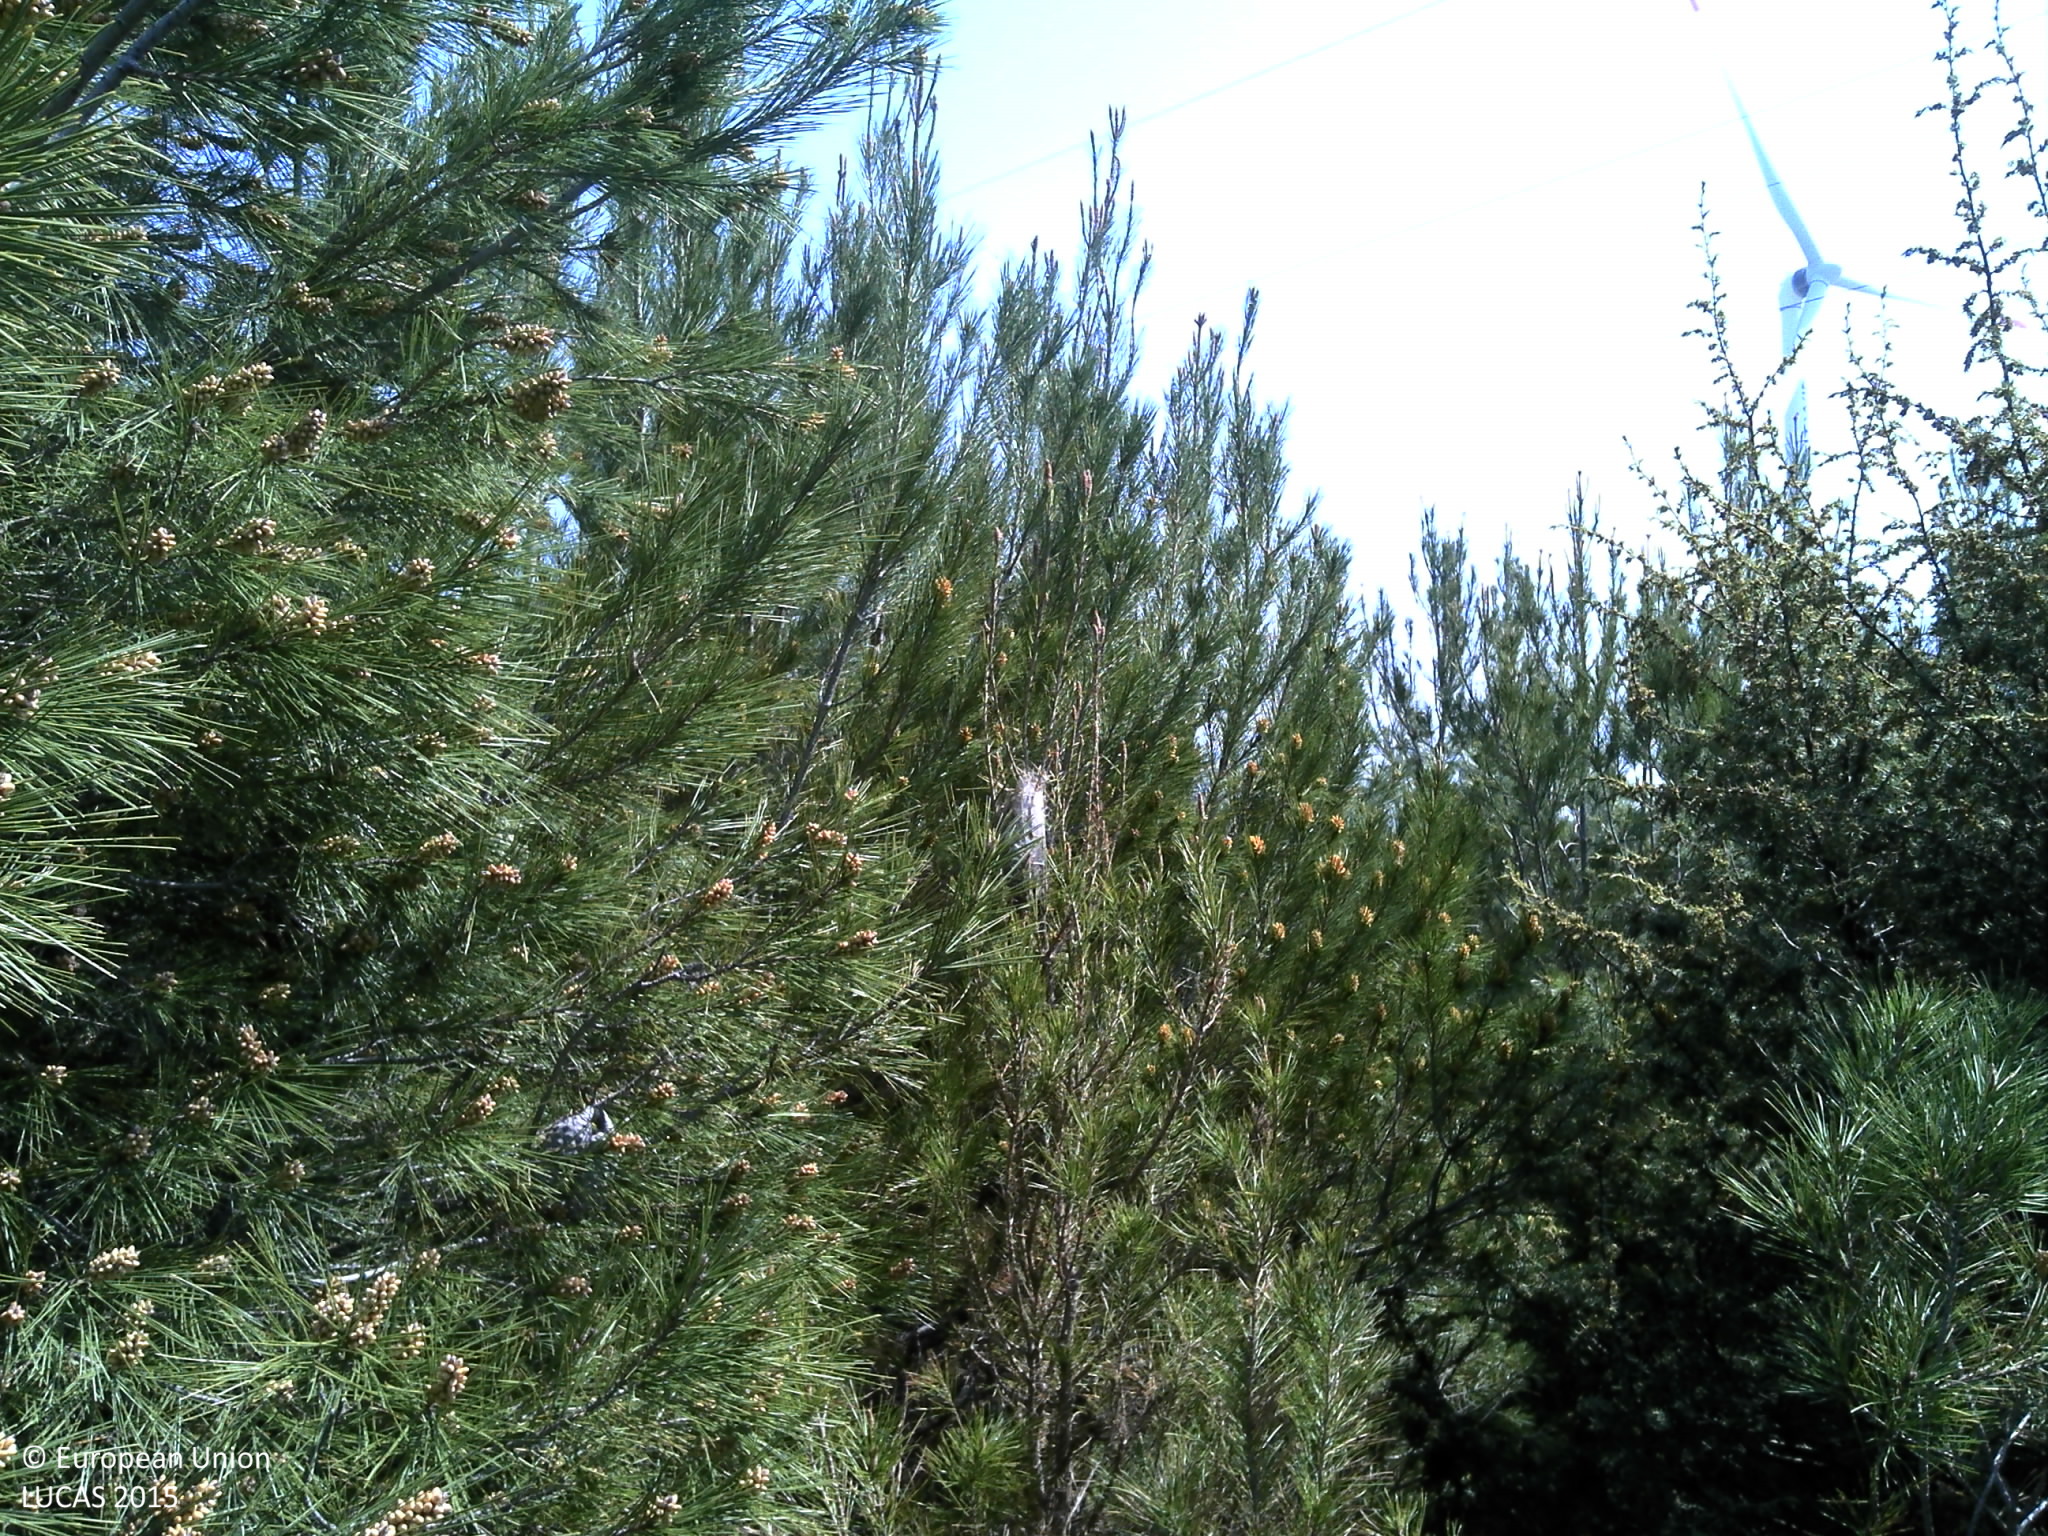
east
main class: Woodland
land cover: Pine dominated coniferous woodland
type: coniferous forest of the mediterranean region
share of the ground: > 75 %
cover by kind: coniferous forest trees 70 %, shrubs 20 %, herbaceous plants 5 %, unconsolidated bare surface 5 %
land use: Semi-natural and natural areas not in use
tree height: > 5 m
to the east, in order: Pine dominated coniferous woodland; Tracks; Electric lines; Pine dominated coniferous woodland; Dry stone walls; Pine dominated coniferous woodland; Dry stone walls; Shrubland with sparse tree cover; Dry stone walls; Pine dominated coniferous woodland; Tracks; Shrubland with sparse tree cover; Tracks; Pine dominated coniferous woodland; Dry stone walls; Shrubland with sparse tree cover; Dry stone walls; Pine dominated coniferous woodland; Tracks; Pine dominated coniferous woodland
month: April
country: HR
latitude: 43.7061
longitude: 16.0098
